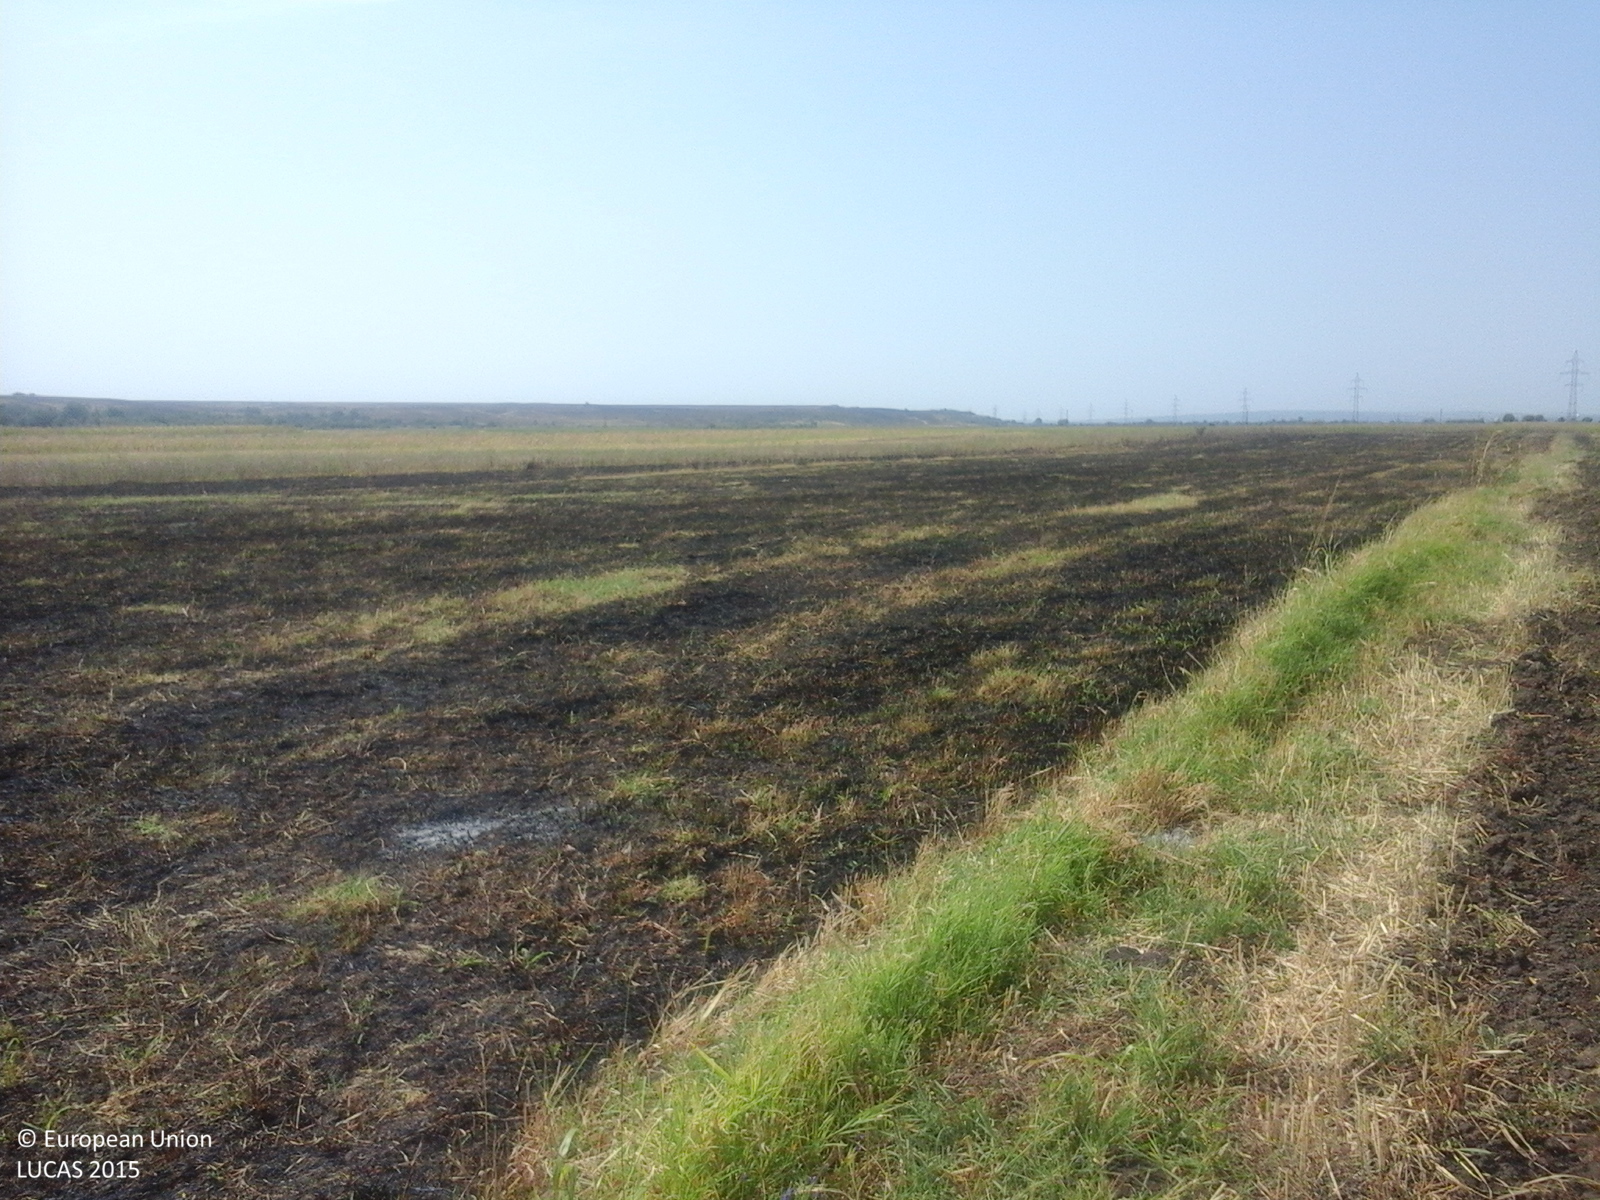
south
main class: Cropland
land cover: Barley
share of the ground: < 10 %
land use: Agriculture (excluding fallow land and kitchen gardens)
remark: Burnt area
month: August
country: RO
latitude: 44.2464
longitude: 22.9538
